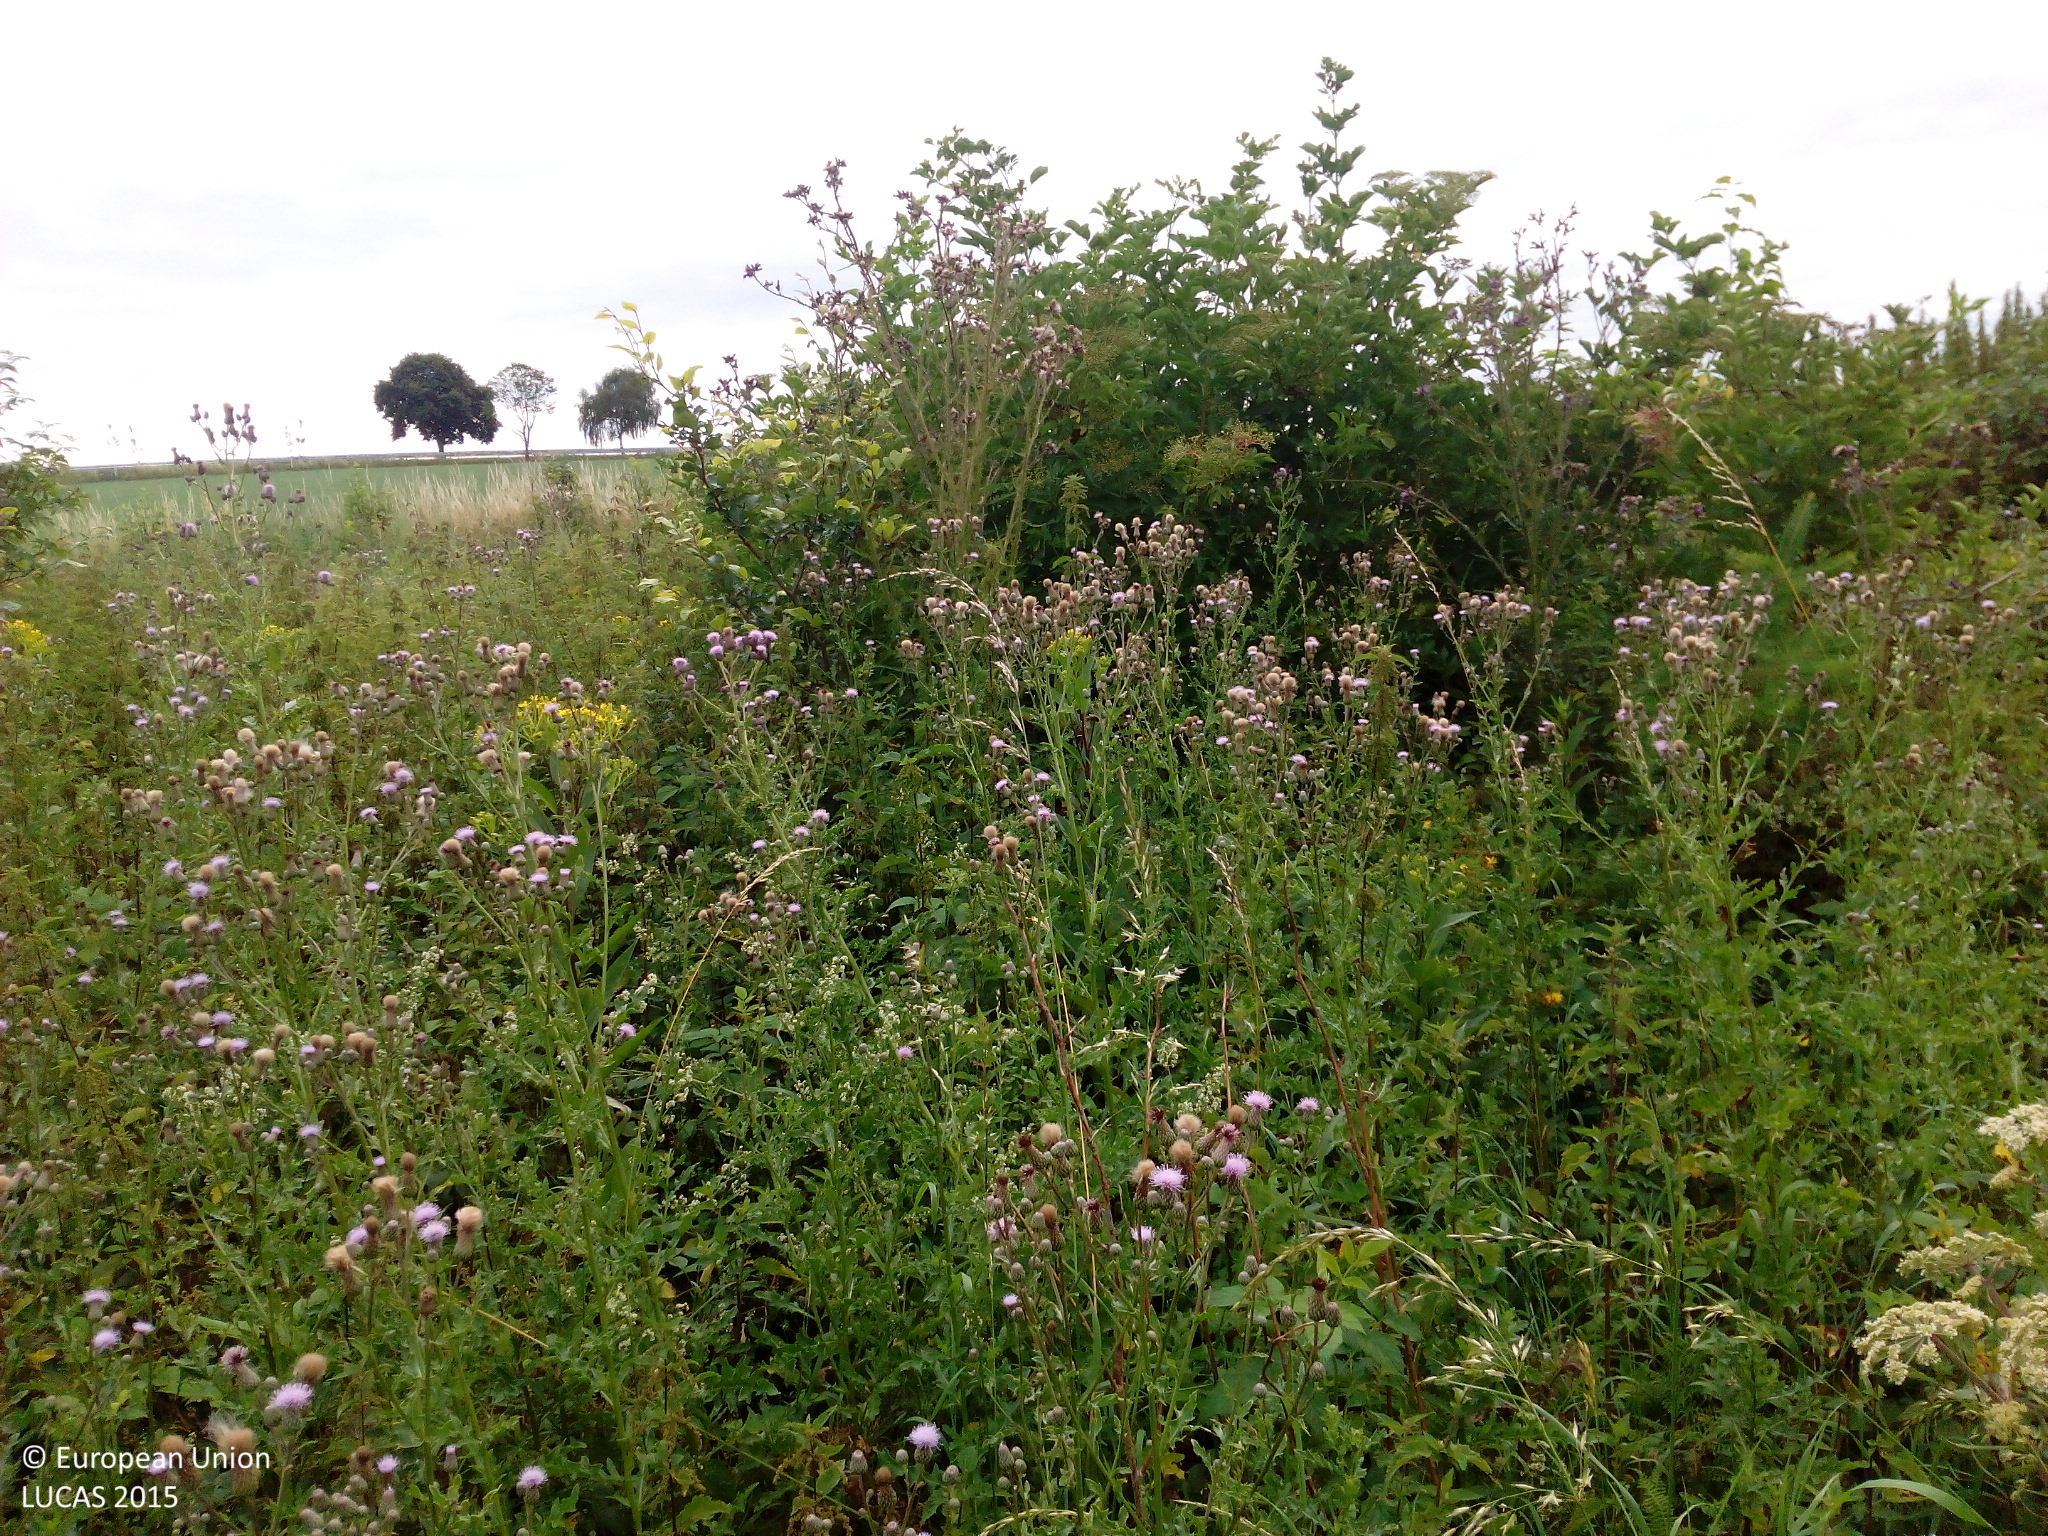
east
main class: Shrubland
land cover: Shrubland with sparse tree cover
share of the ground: 50 - 75 %
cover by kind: shrubs 65 %, herbaceous plants 30 %, coniferous forest trees 5 %
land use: Forestry
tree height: < 5 m
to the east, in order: Shrubland with sparse tree cover; Grassland without tree/shrub cover; Temporary grasslands; Grass margins; Paved roads, cycling and walking lanes; Grassland without tree/shrub cover; Lines of trees; Maize
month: July
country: DE
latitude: 49.8241
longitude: 7.1228
